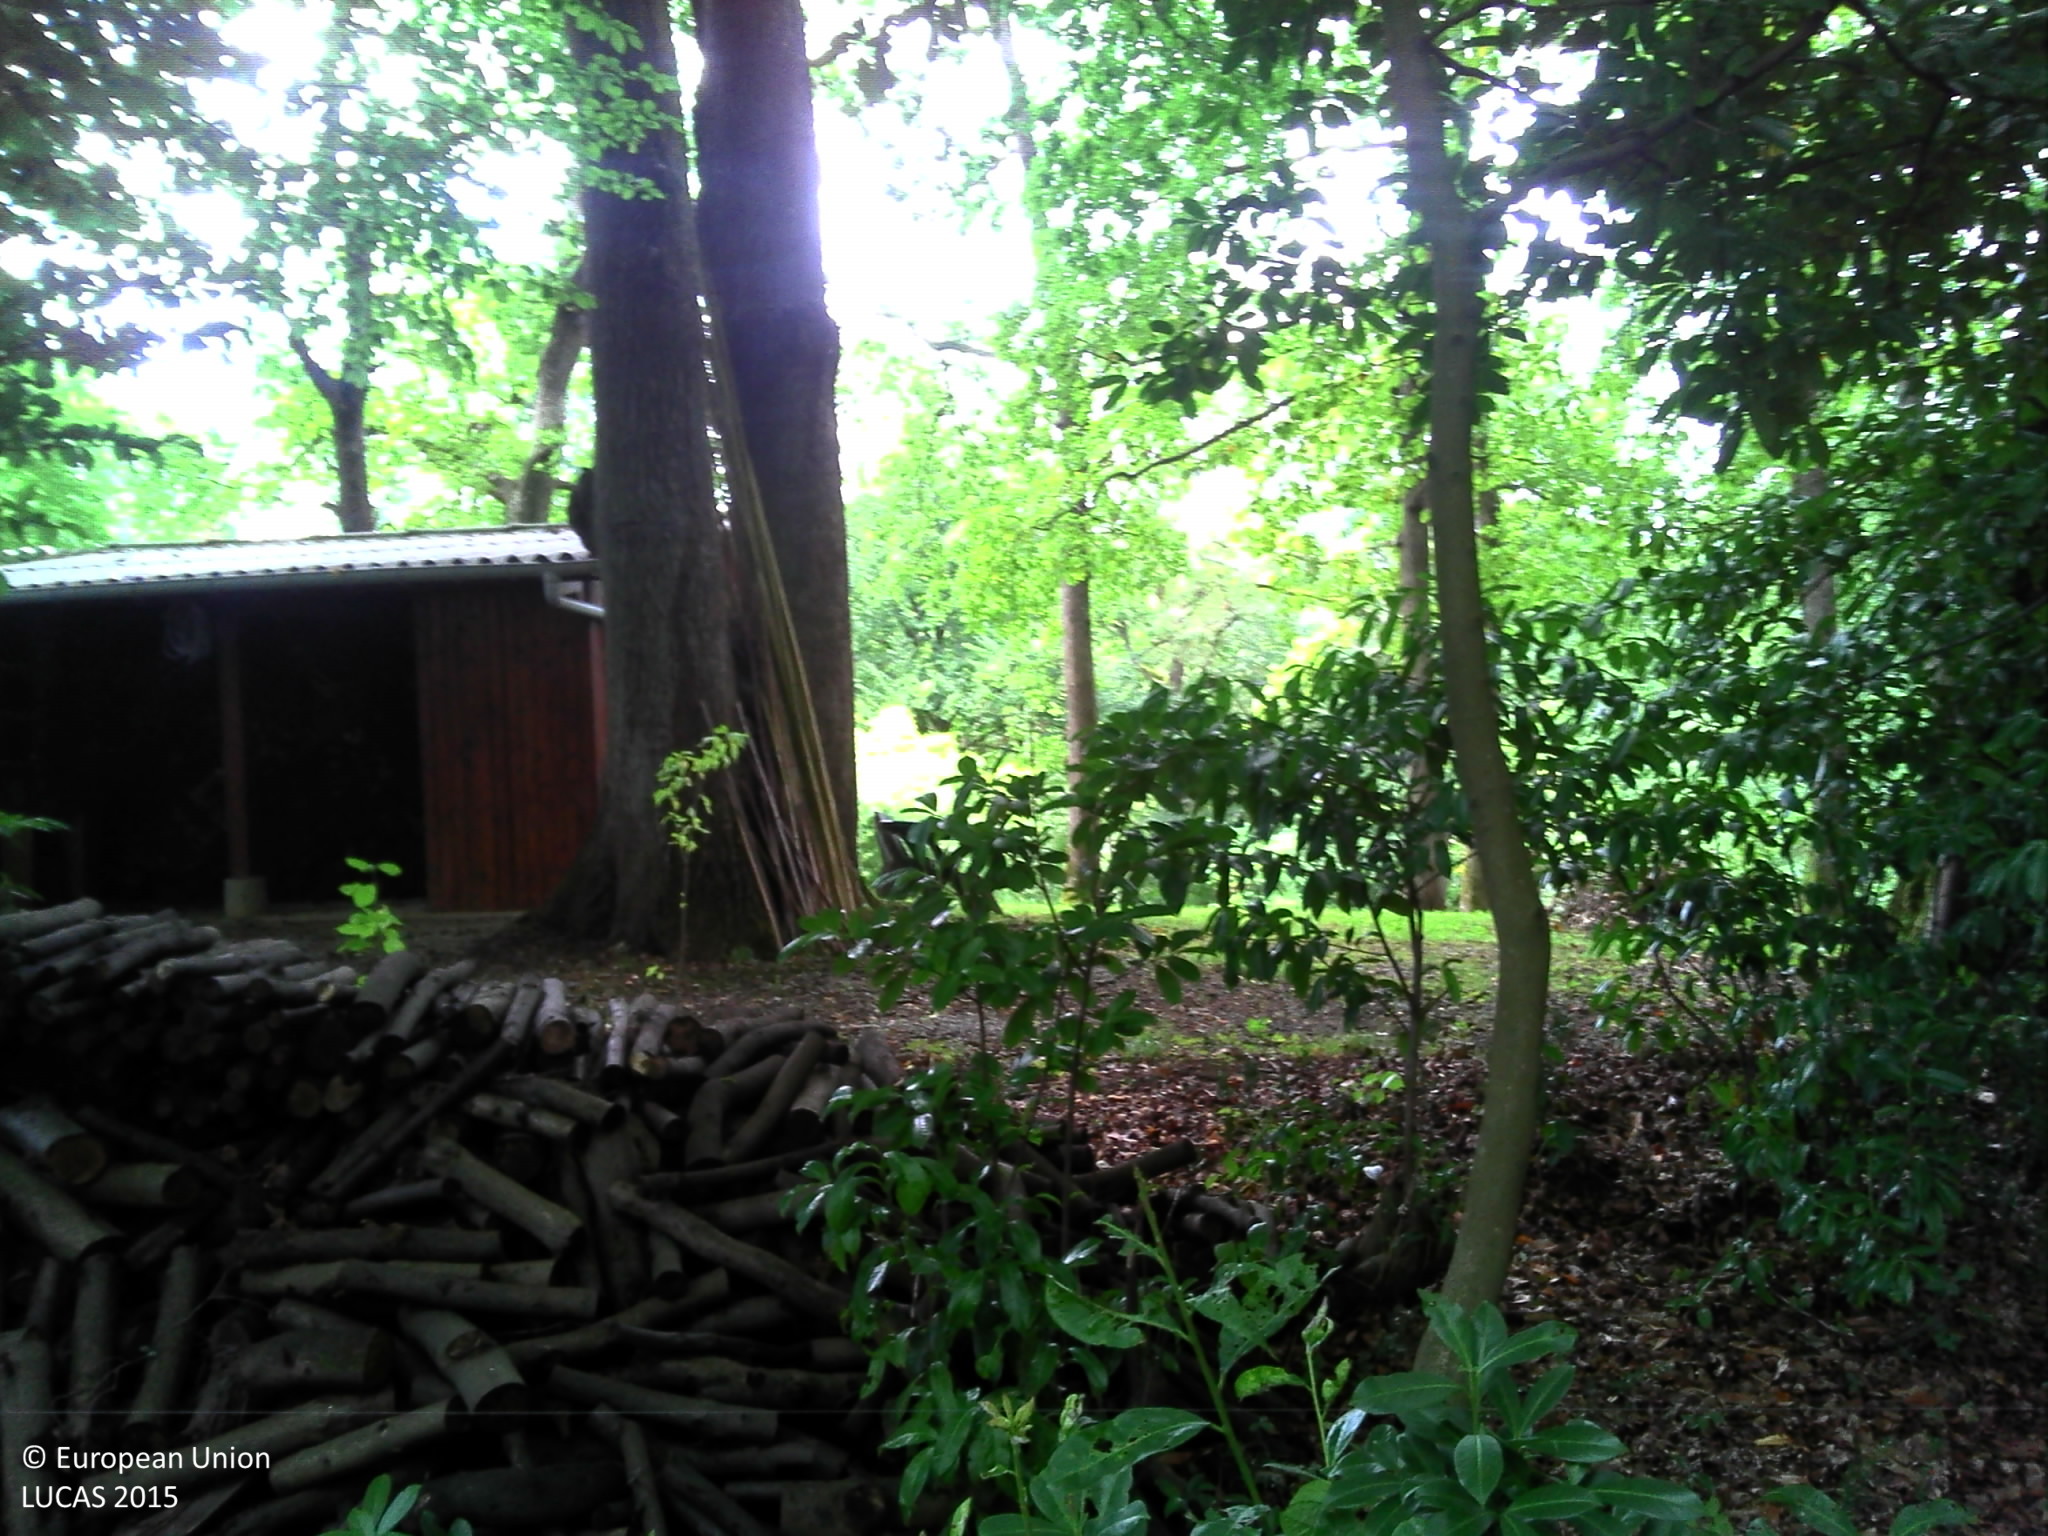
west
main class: Woodland
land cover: Broadleaved woodland
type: acidophilous oak and oak-birch forest
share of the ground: > 75 %
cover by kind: broadleaved forest trees 80 %, shrubs 10 %, herbaceous plants 5 %, lichens and mosses 5 %
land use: Forestry
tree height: > 5 m
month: September
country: FR
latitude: 43.2818
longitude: -0.3953
